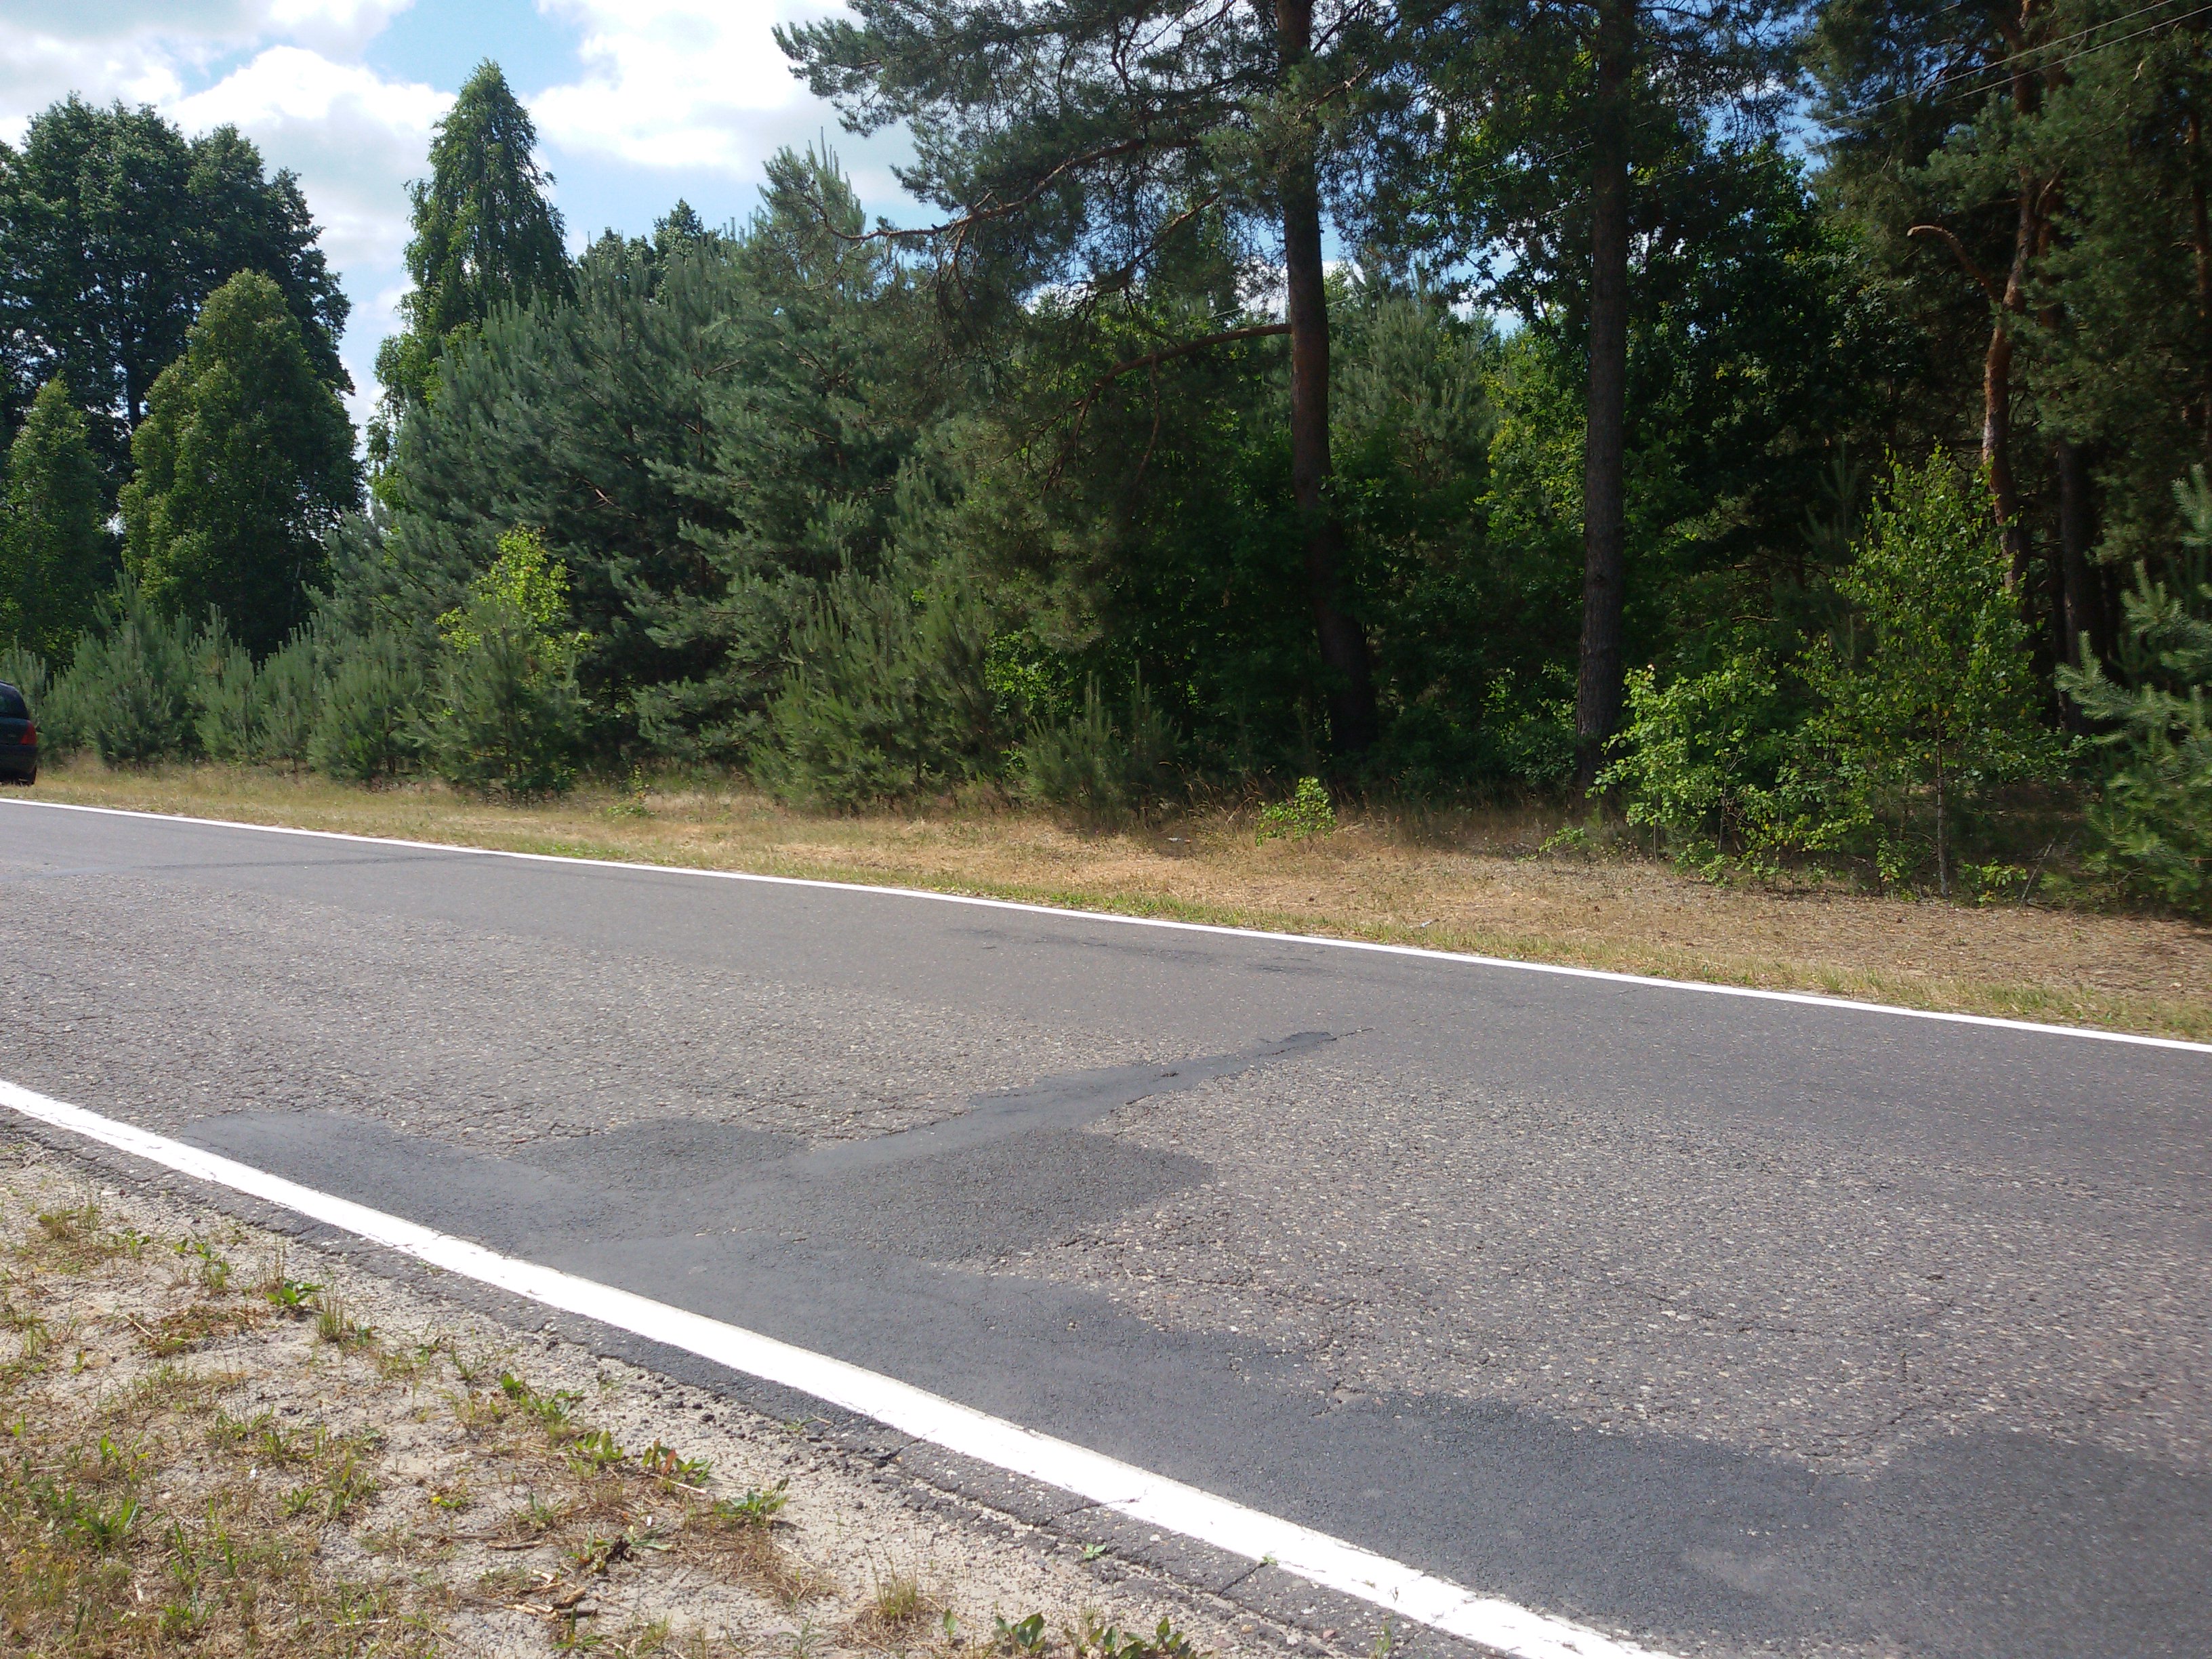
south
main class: Woodland
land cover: Spruce dominated coniferous woodland
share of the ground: > 75 %
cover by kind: coniferous forest trees 95 %, herbaceous plants 5 %
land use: Forestry
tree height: < 5 m
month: June
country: PL
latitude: 51.8277
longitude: 23.5952
